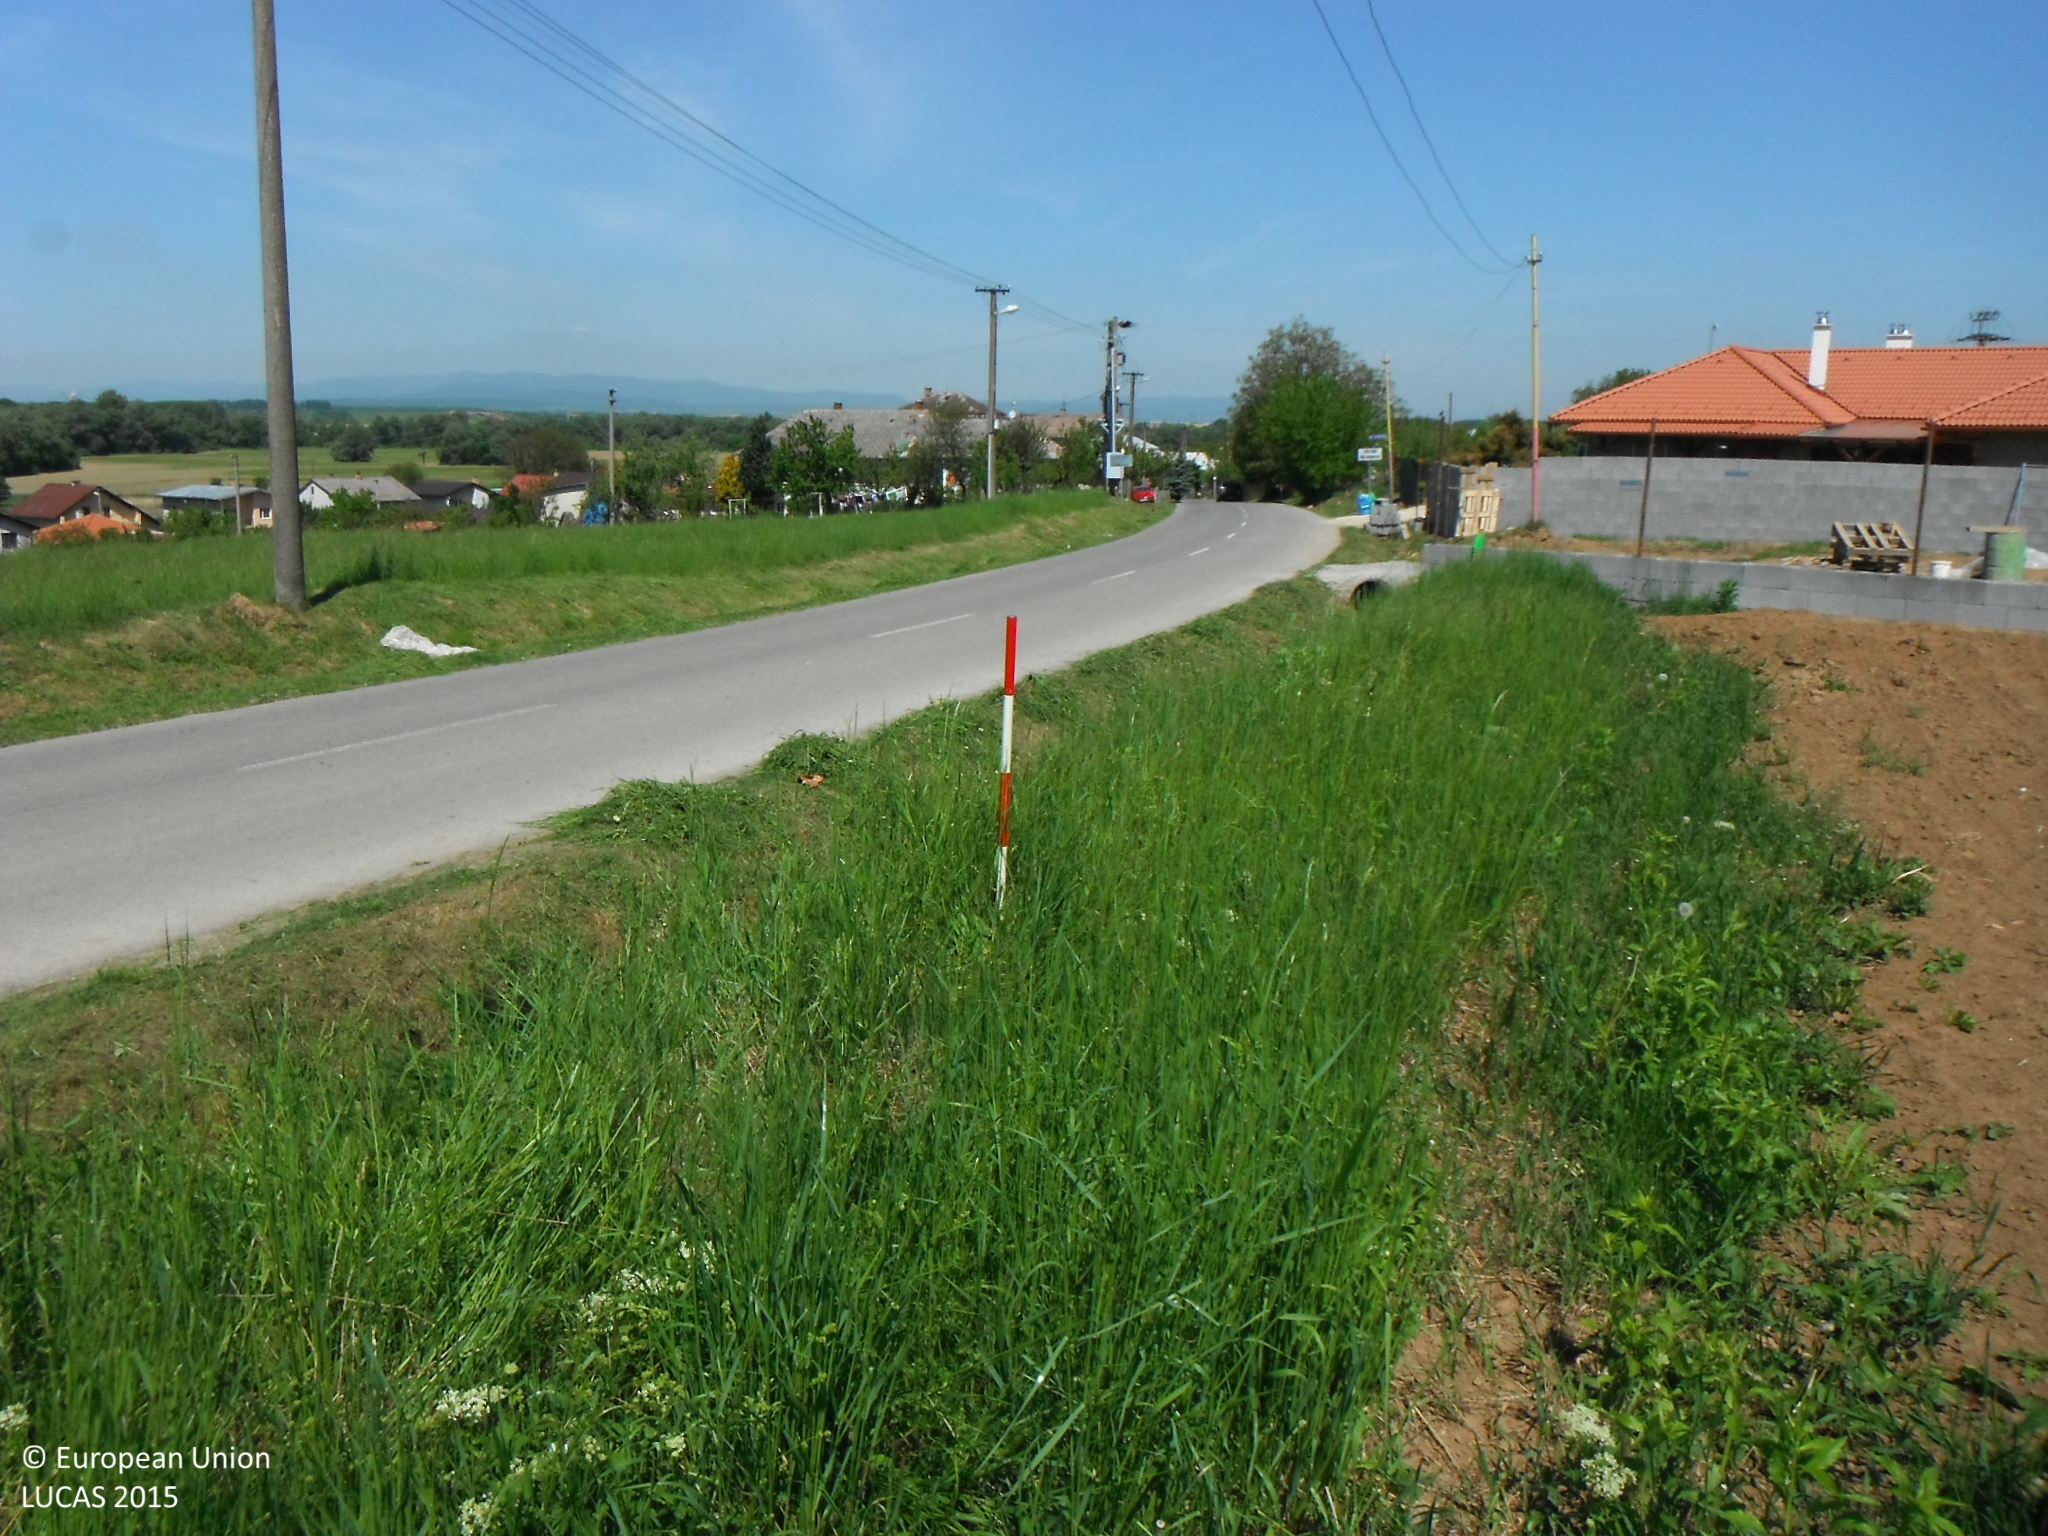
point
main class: Cropland
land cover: Maize
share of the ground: < 10 %
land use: Agriculture (excluding fallow land and kitchen gardens)
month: May
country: SK
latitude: 48.5636
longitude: 21.3328
